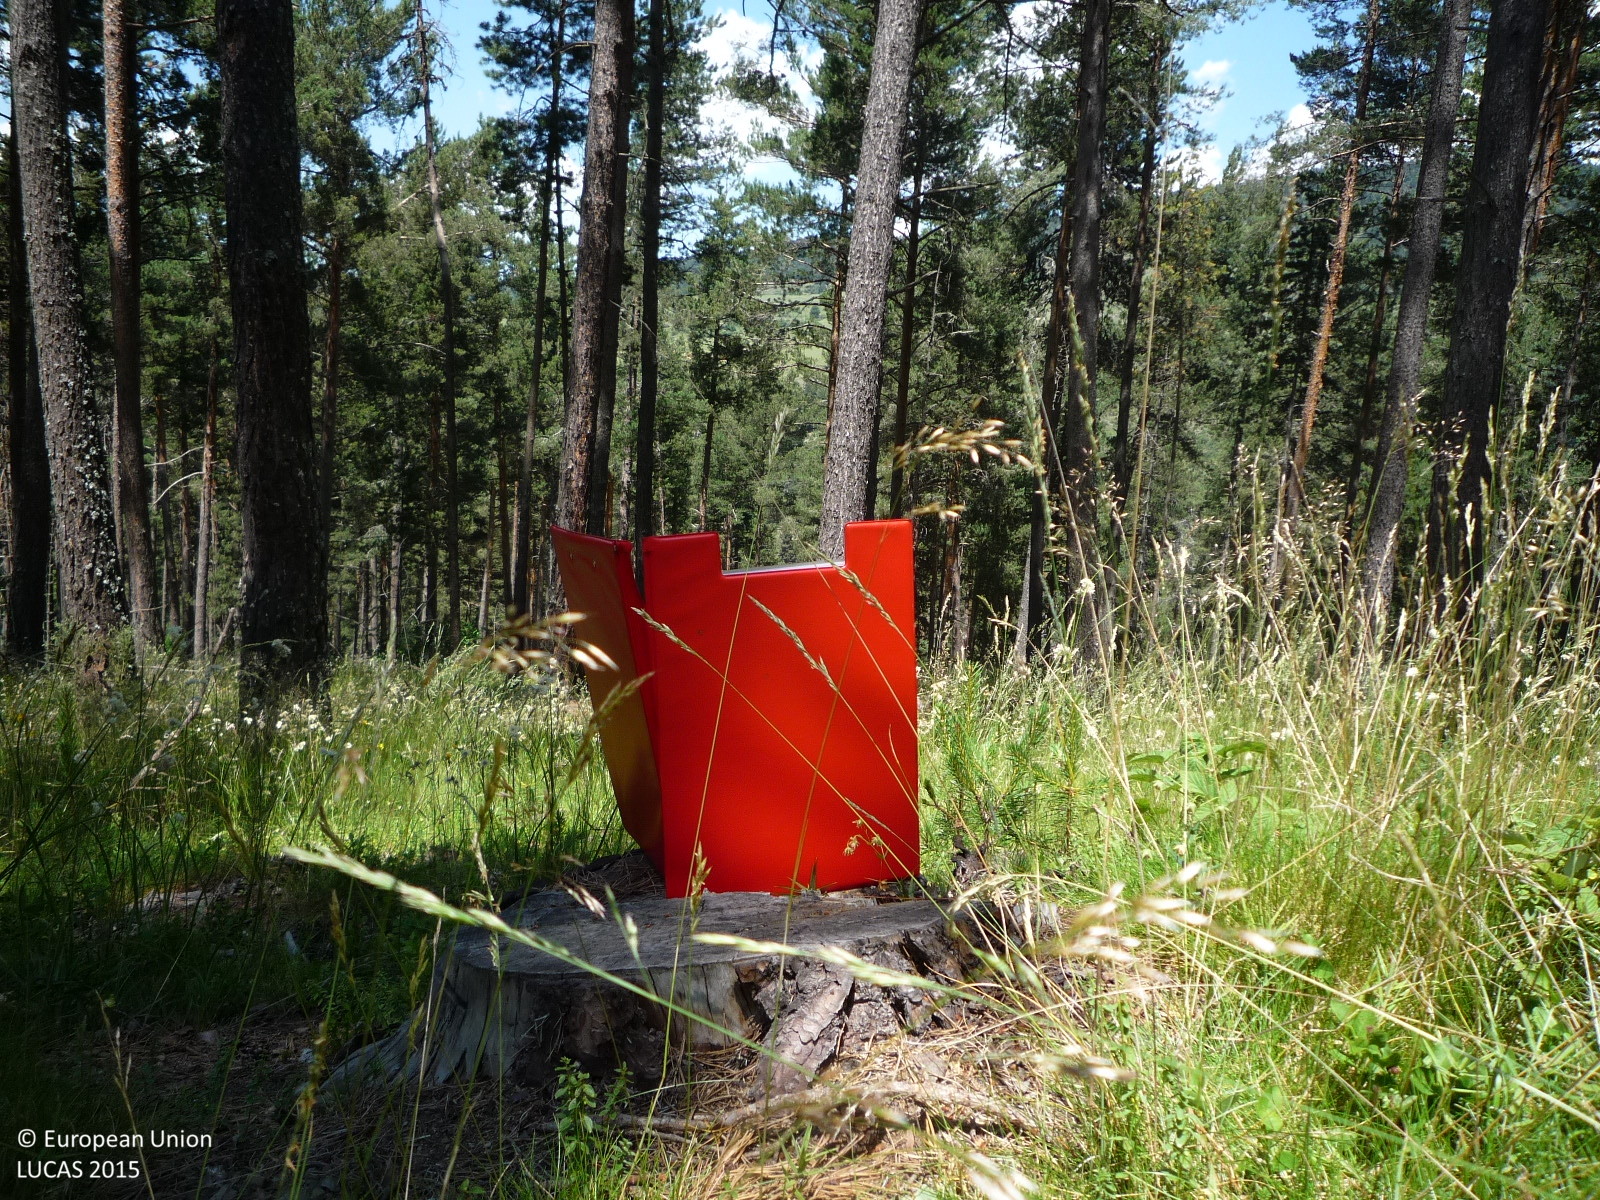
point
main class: Woodland
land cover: Pine dominated coniferous woodland
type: alpine coniferous forest
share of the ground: > 75 %
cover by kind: coniferous forest trees 90 %, herbaceous plants 10 %
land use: Forestry
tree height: > 5 m
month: June
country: ES
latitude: 42.3524
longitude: 1.9629
